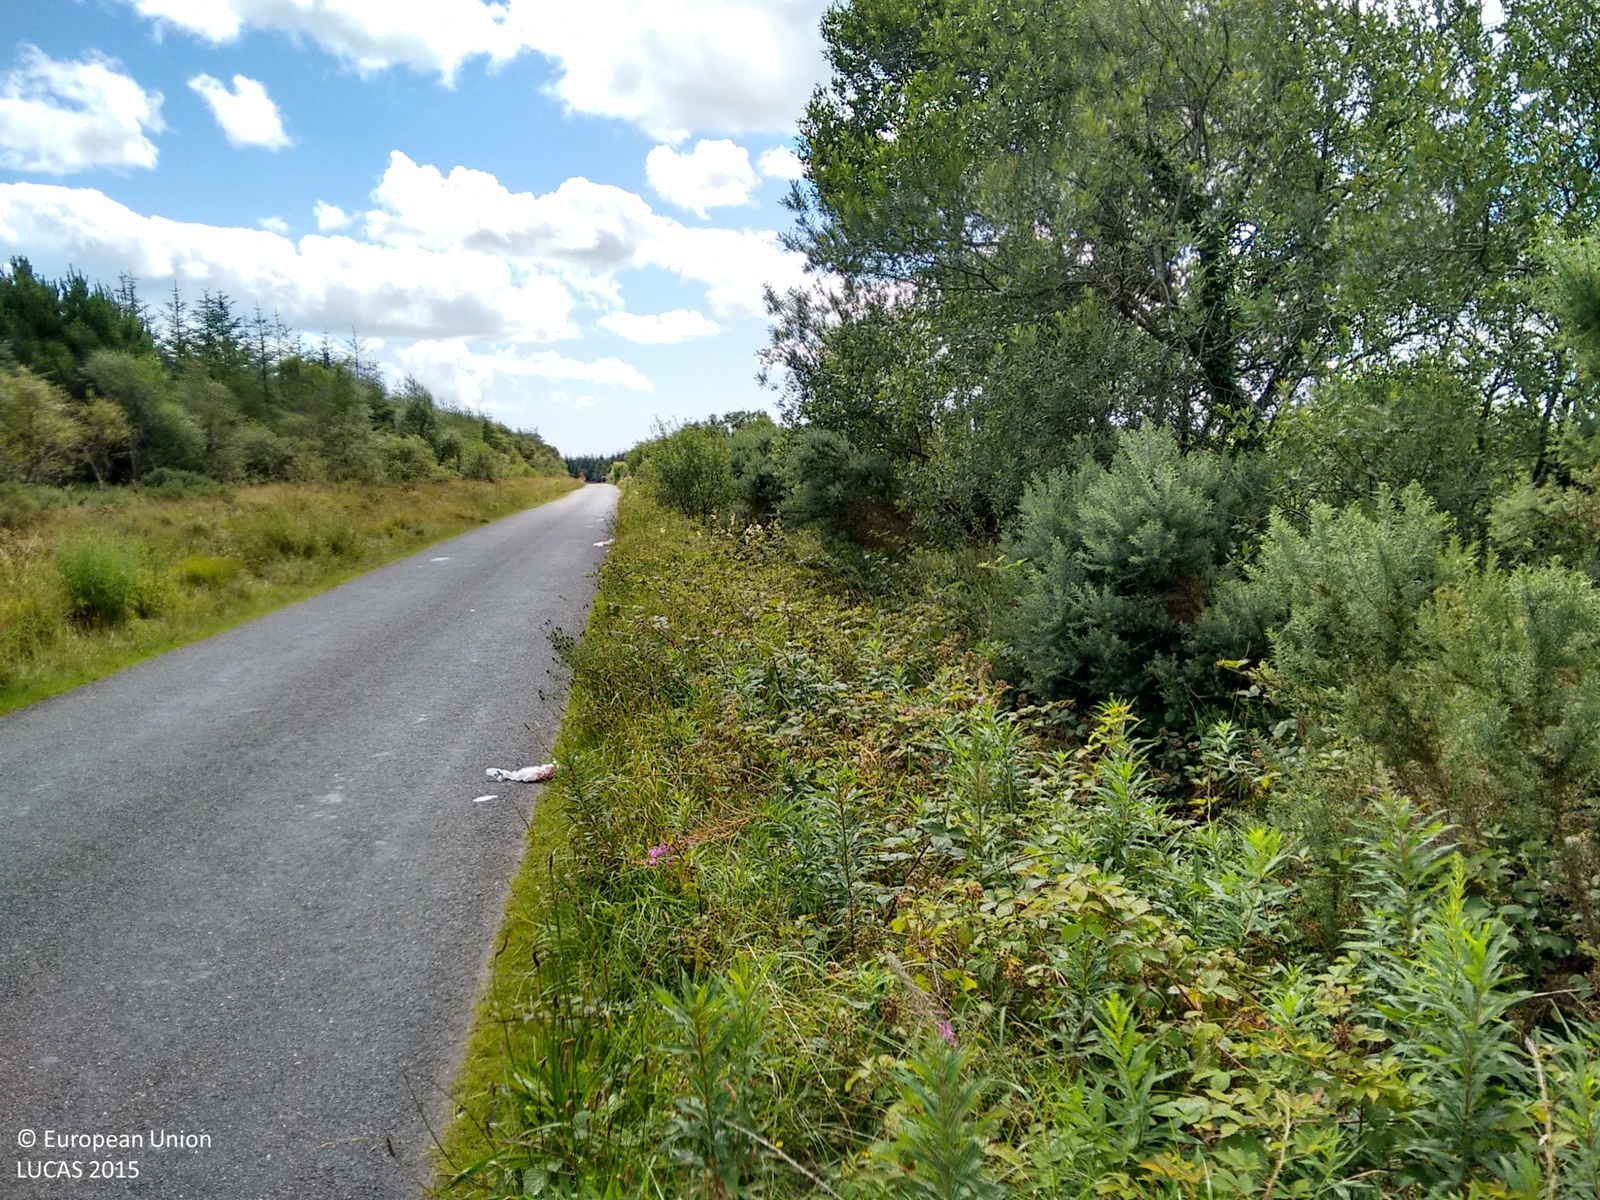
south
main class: Woodland
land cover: Other mixed woodland
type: exotic forest
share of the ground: > 75 %
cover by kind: coniferous forest trees 50 %, broadleaved forest trees 50 %
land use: Forestry
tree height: < 5 m
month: August
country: IE
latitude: 52.3728
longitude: -7.1115
